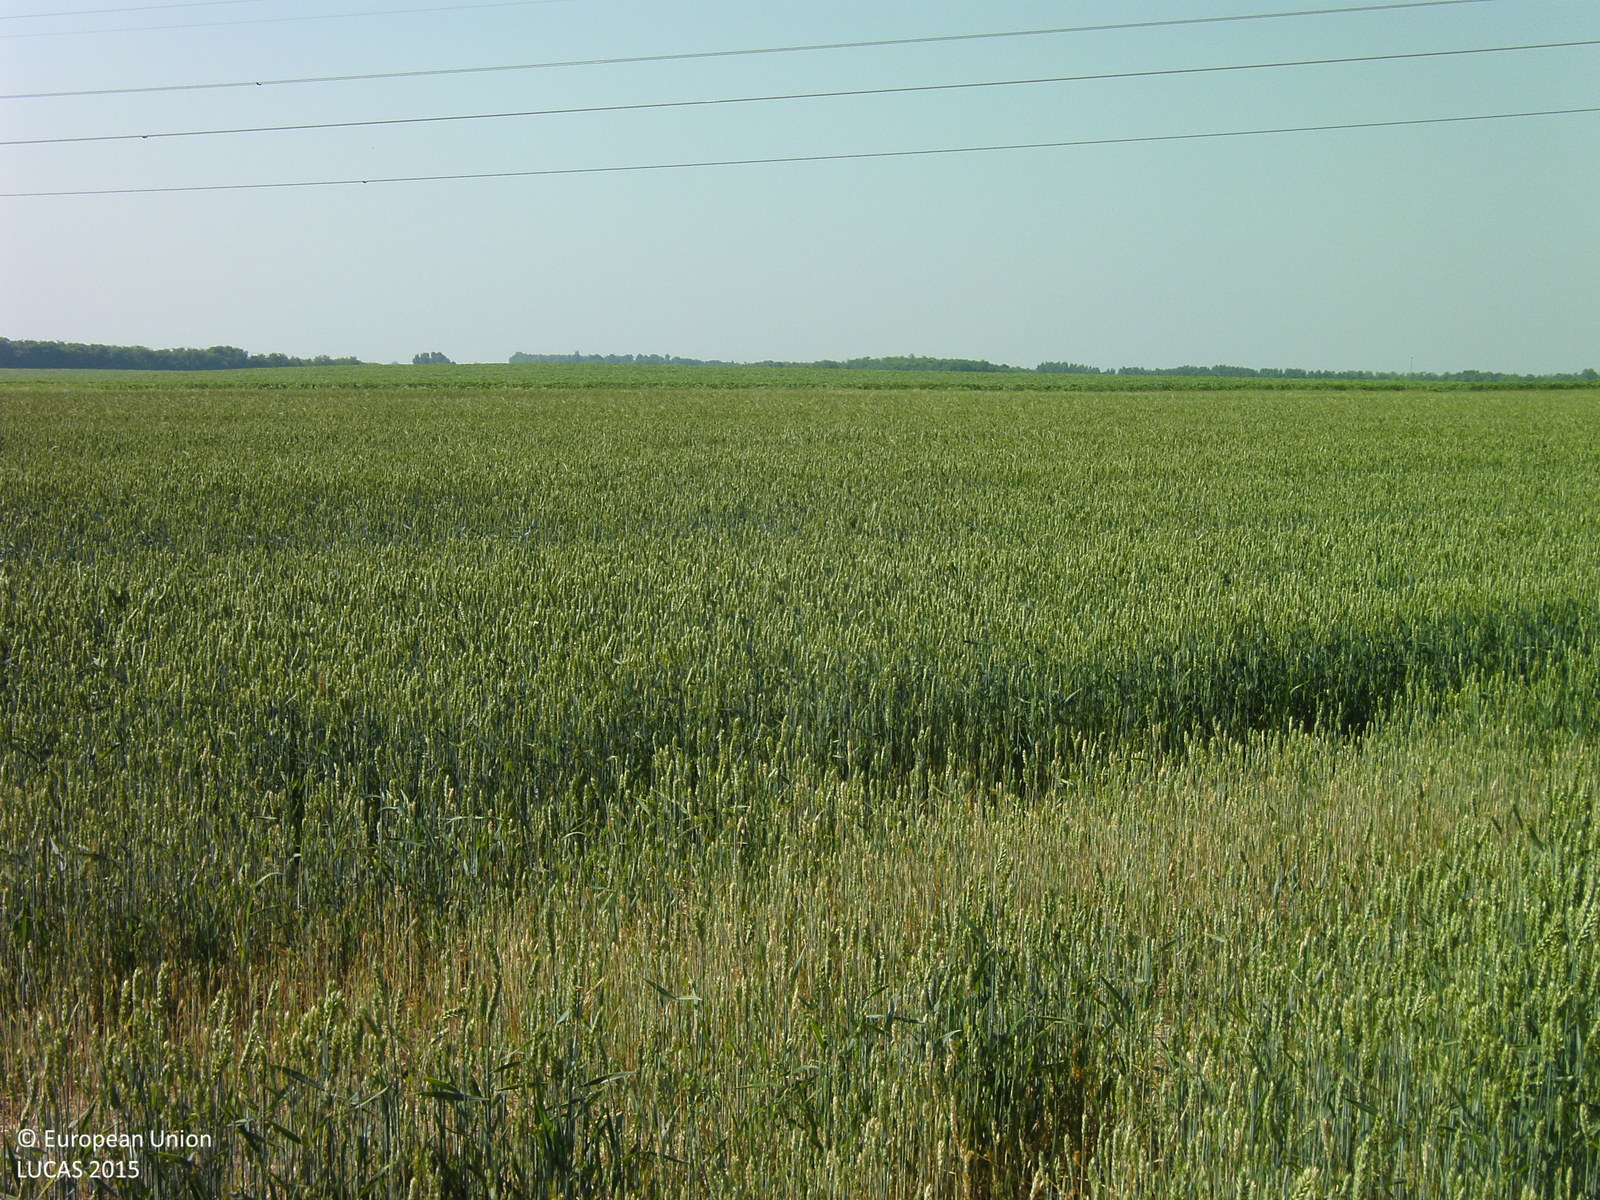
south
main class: Cropland
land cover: Common wheat
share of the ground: > 75 %
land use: Agriculture (excluding fallow land and kitchen gardens)
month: June
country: HU
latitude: 46.4730
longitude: 17.6767
